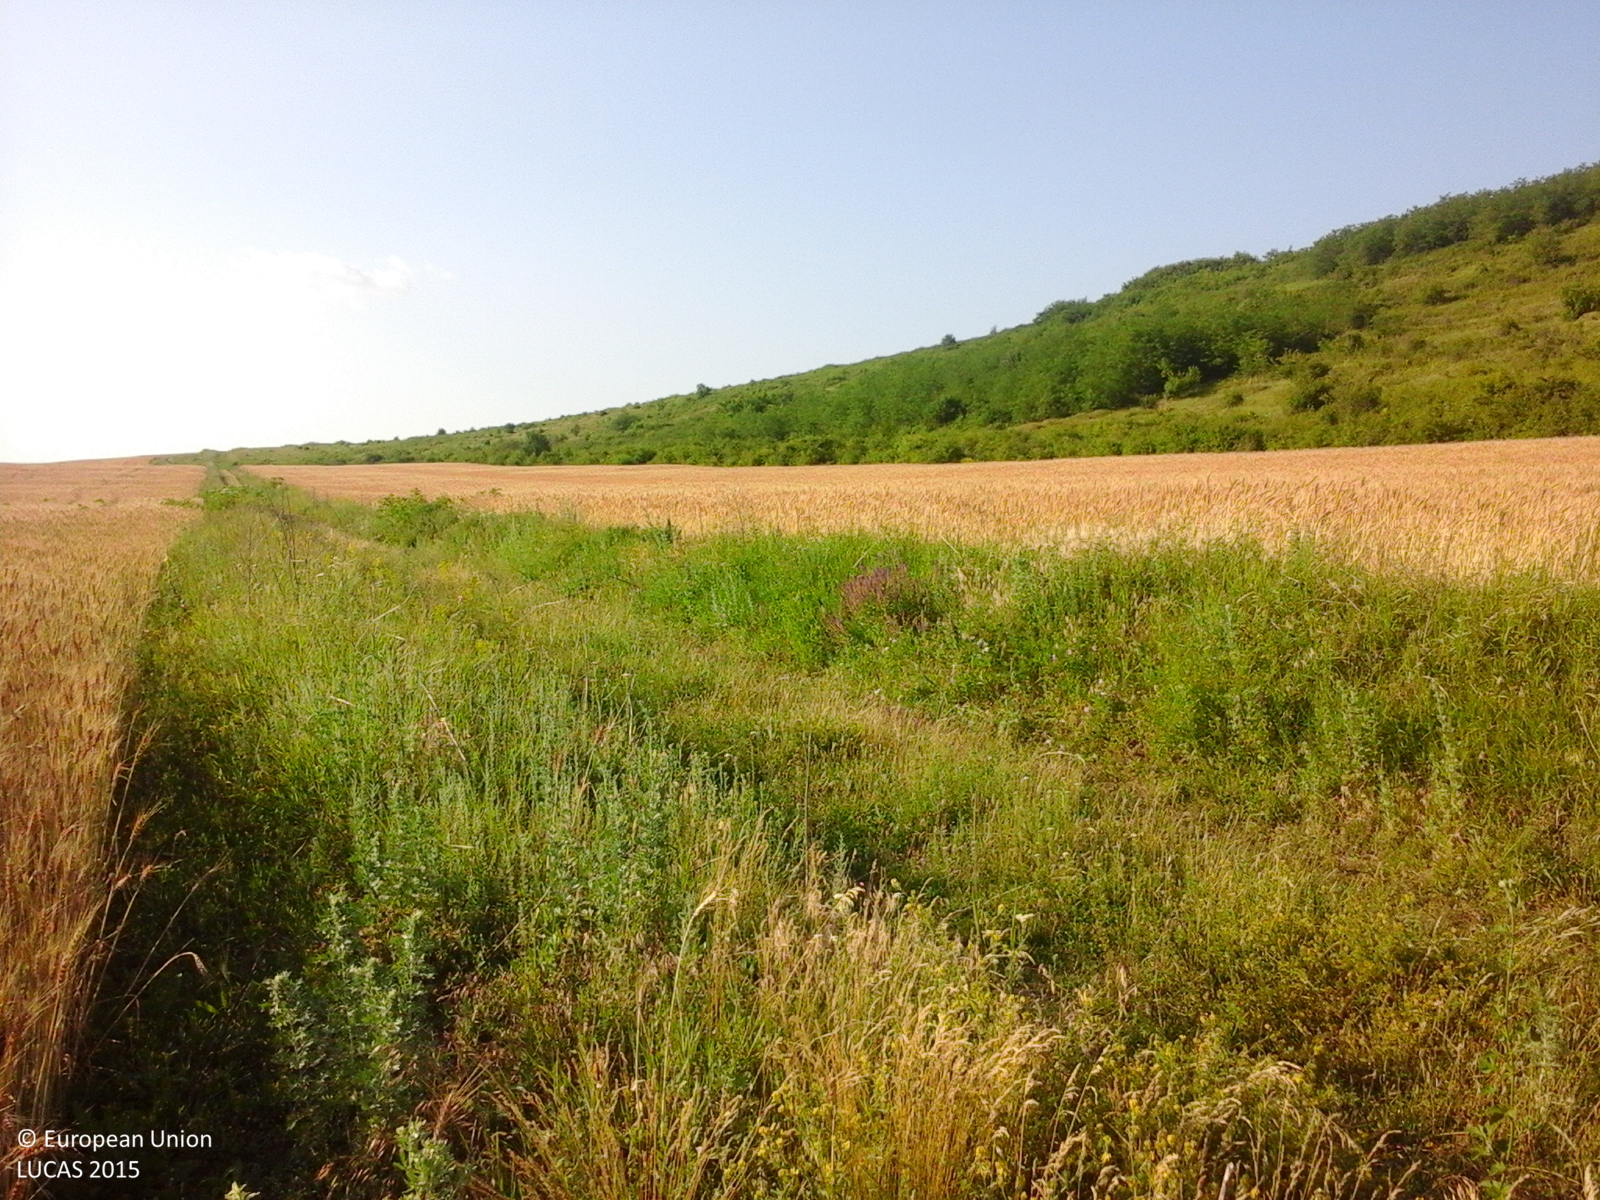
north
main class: Cropland
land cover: Common wheat
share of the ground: > 75 %
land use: Agriculture (excluding fallow land and kitchen gardens)
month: June
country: RO
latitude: 46.5469
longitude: 27.4145
